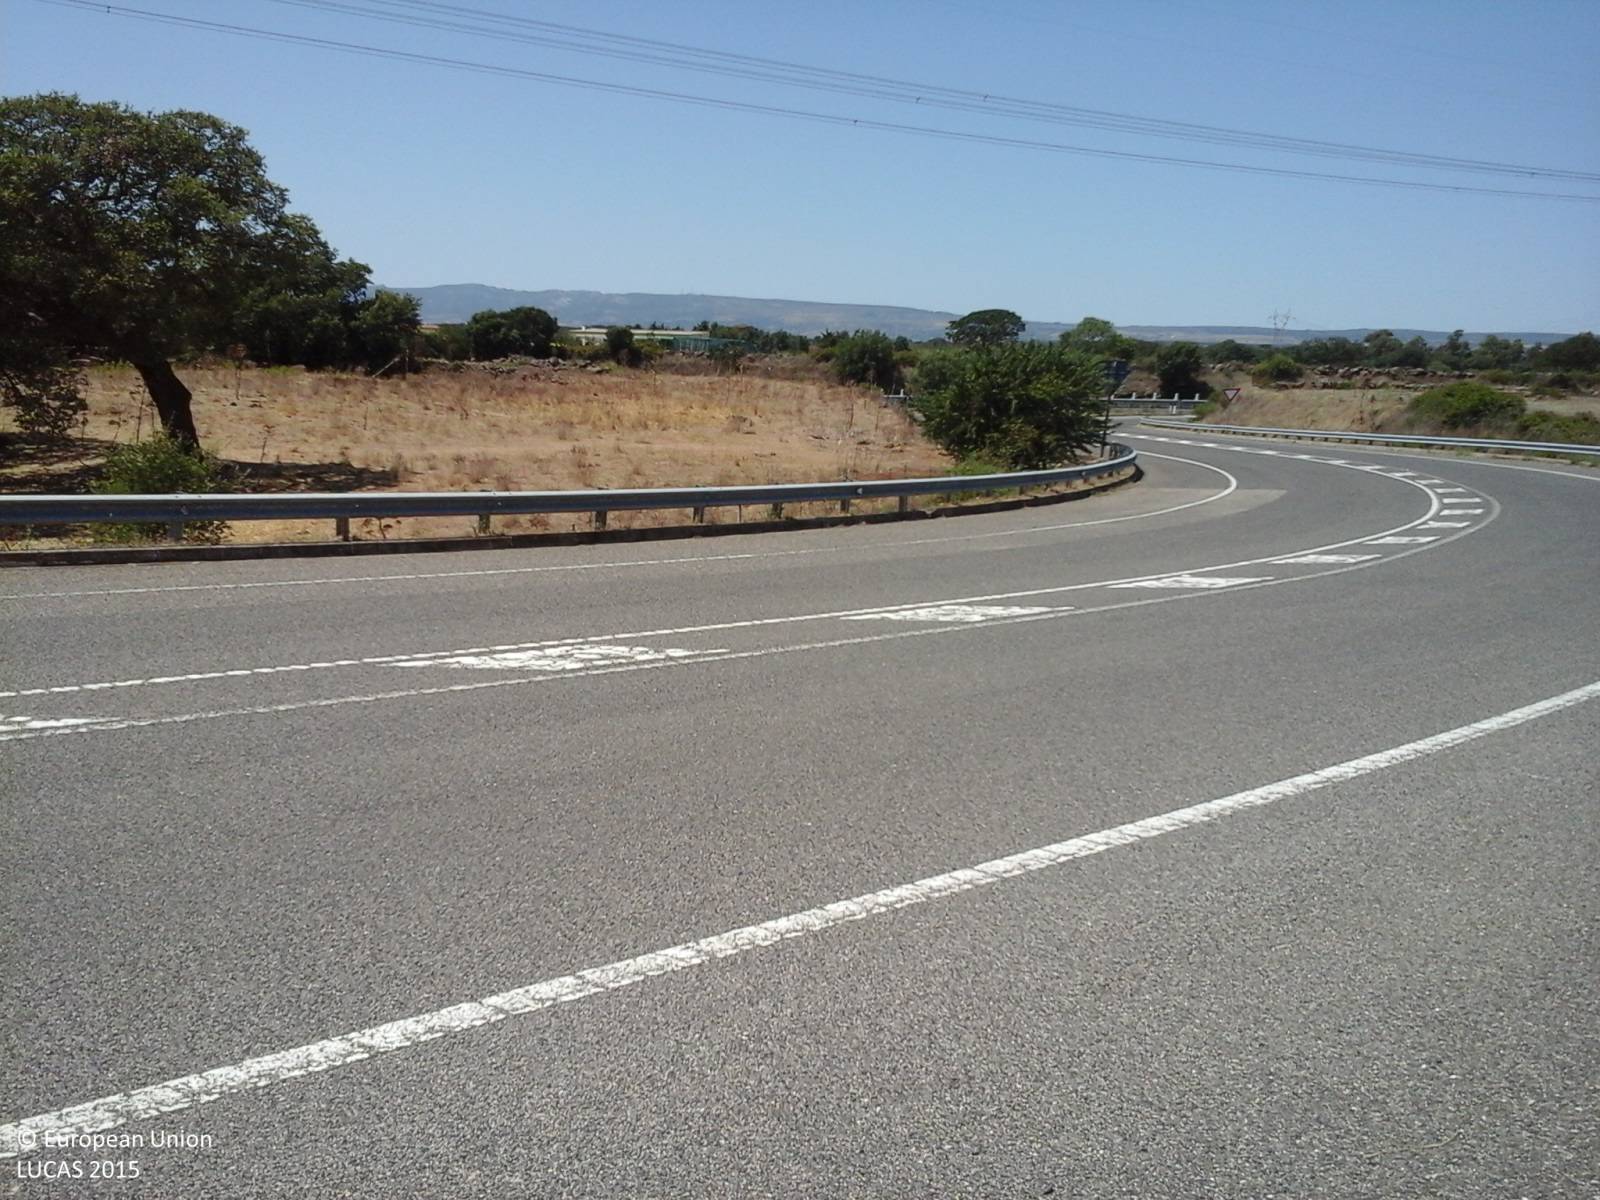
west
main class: Grassland
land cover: Grassland without tree/shrub cover
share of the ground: > 75 %
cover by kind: herbaceous plants 100 %
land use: Agriculture (excluding fallow land and kitchen gardens)
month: August
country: IT
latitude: 40.1151
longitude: 8.7980
